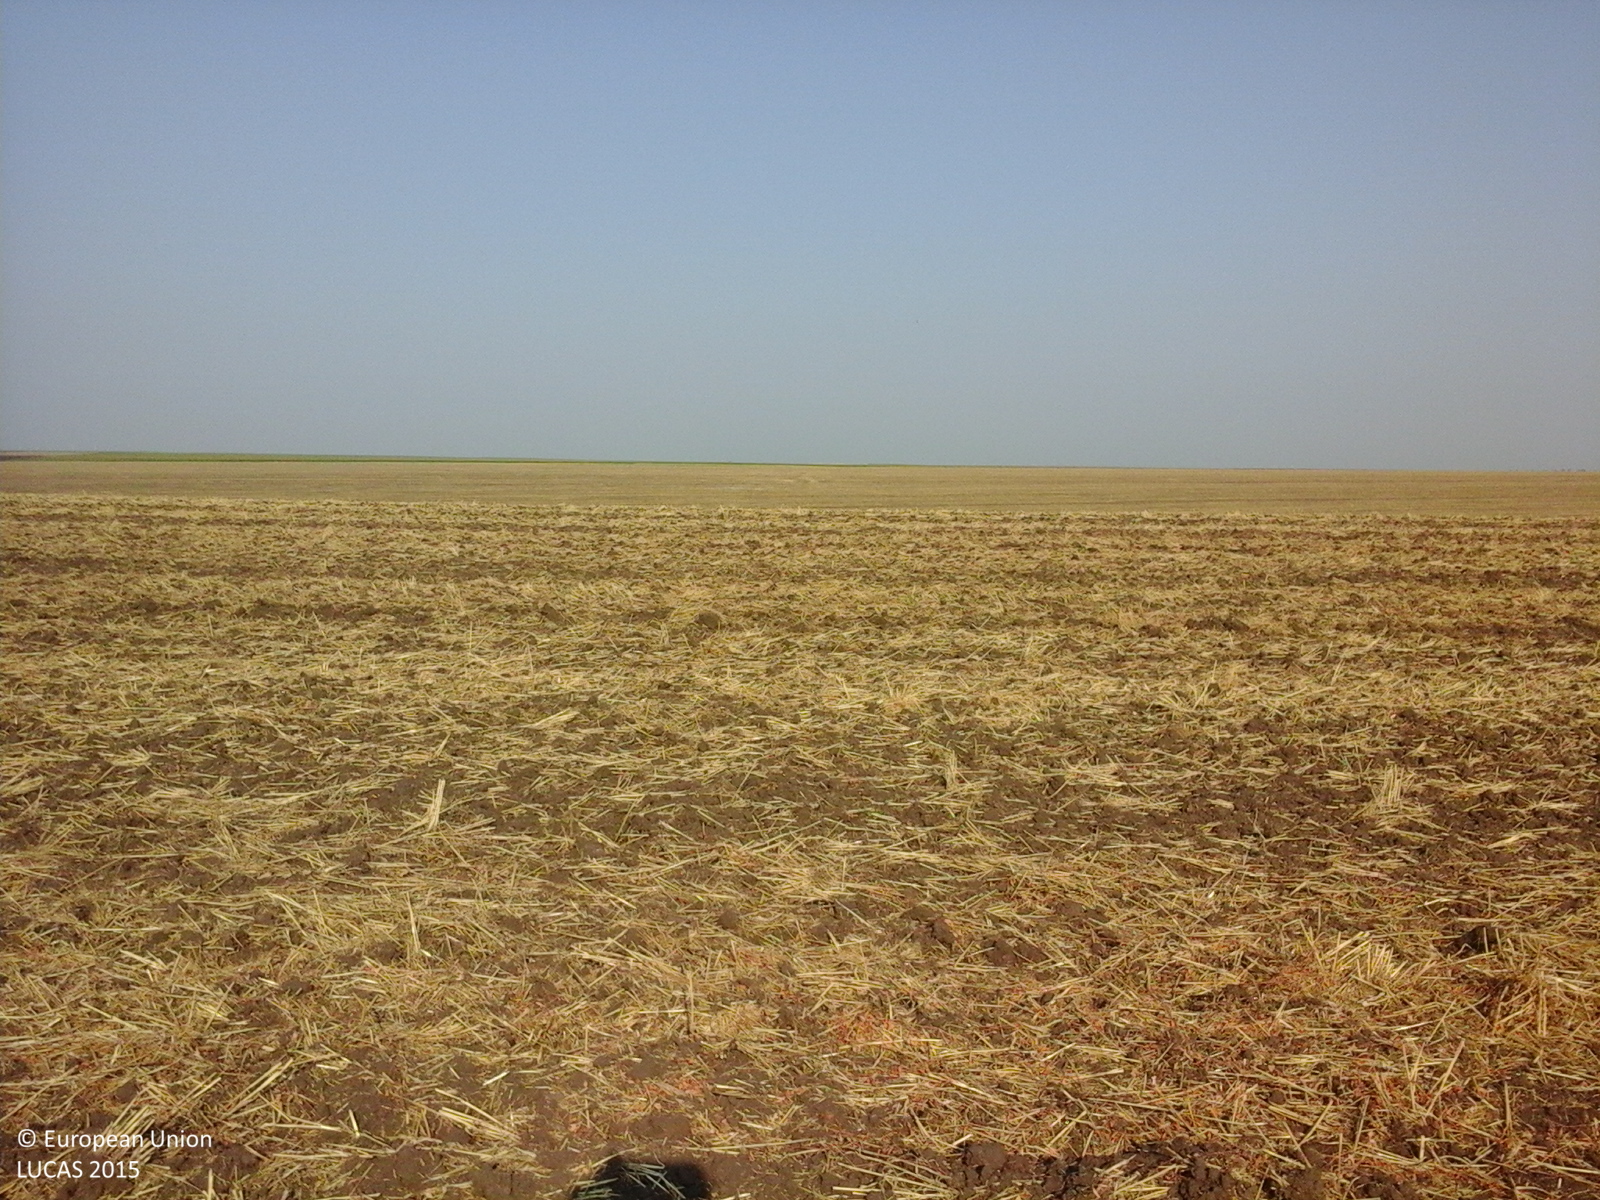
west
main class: Cropland
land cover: Common wheat
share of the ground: 25 - 50 %
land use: Agriculture (excluding fallow land and kitchen gardens)
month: July
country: RO
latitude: 45.6870
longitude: 27.9265
